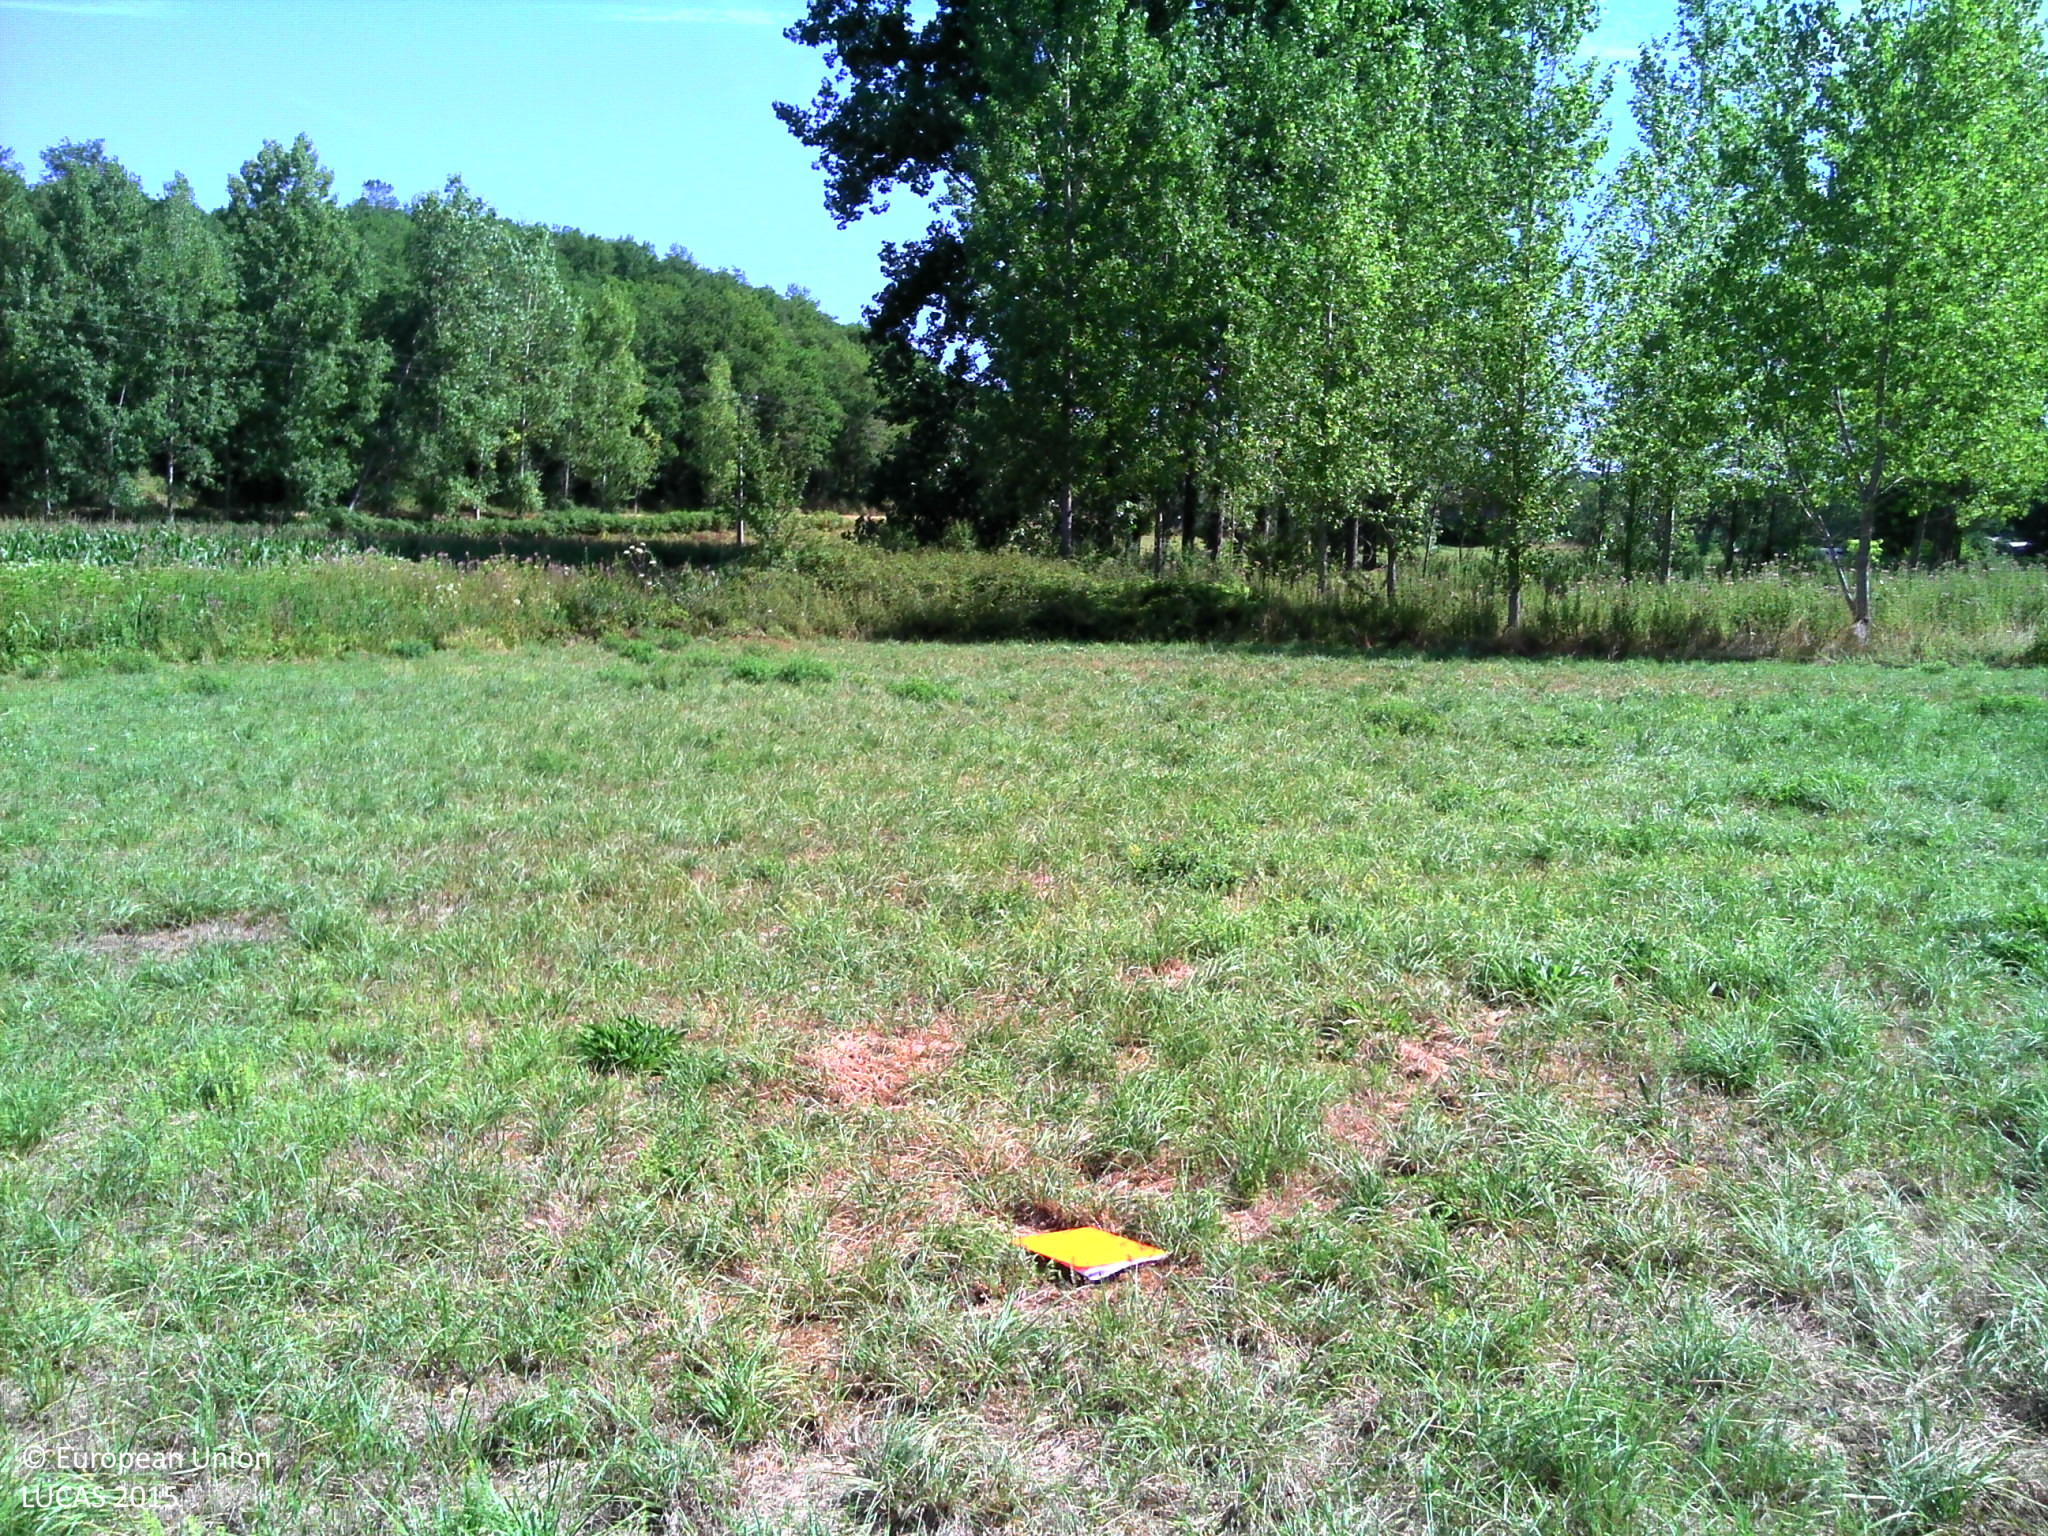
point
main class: Grassland
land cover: Grassland without tree/shrub cover
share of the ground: > 75 %
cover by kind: herbaceous plants 100 %
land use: Agriculture (excluding fallow land and kitchen gardens)
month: July
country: FR
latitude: 44.9717
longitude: 1.1818
